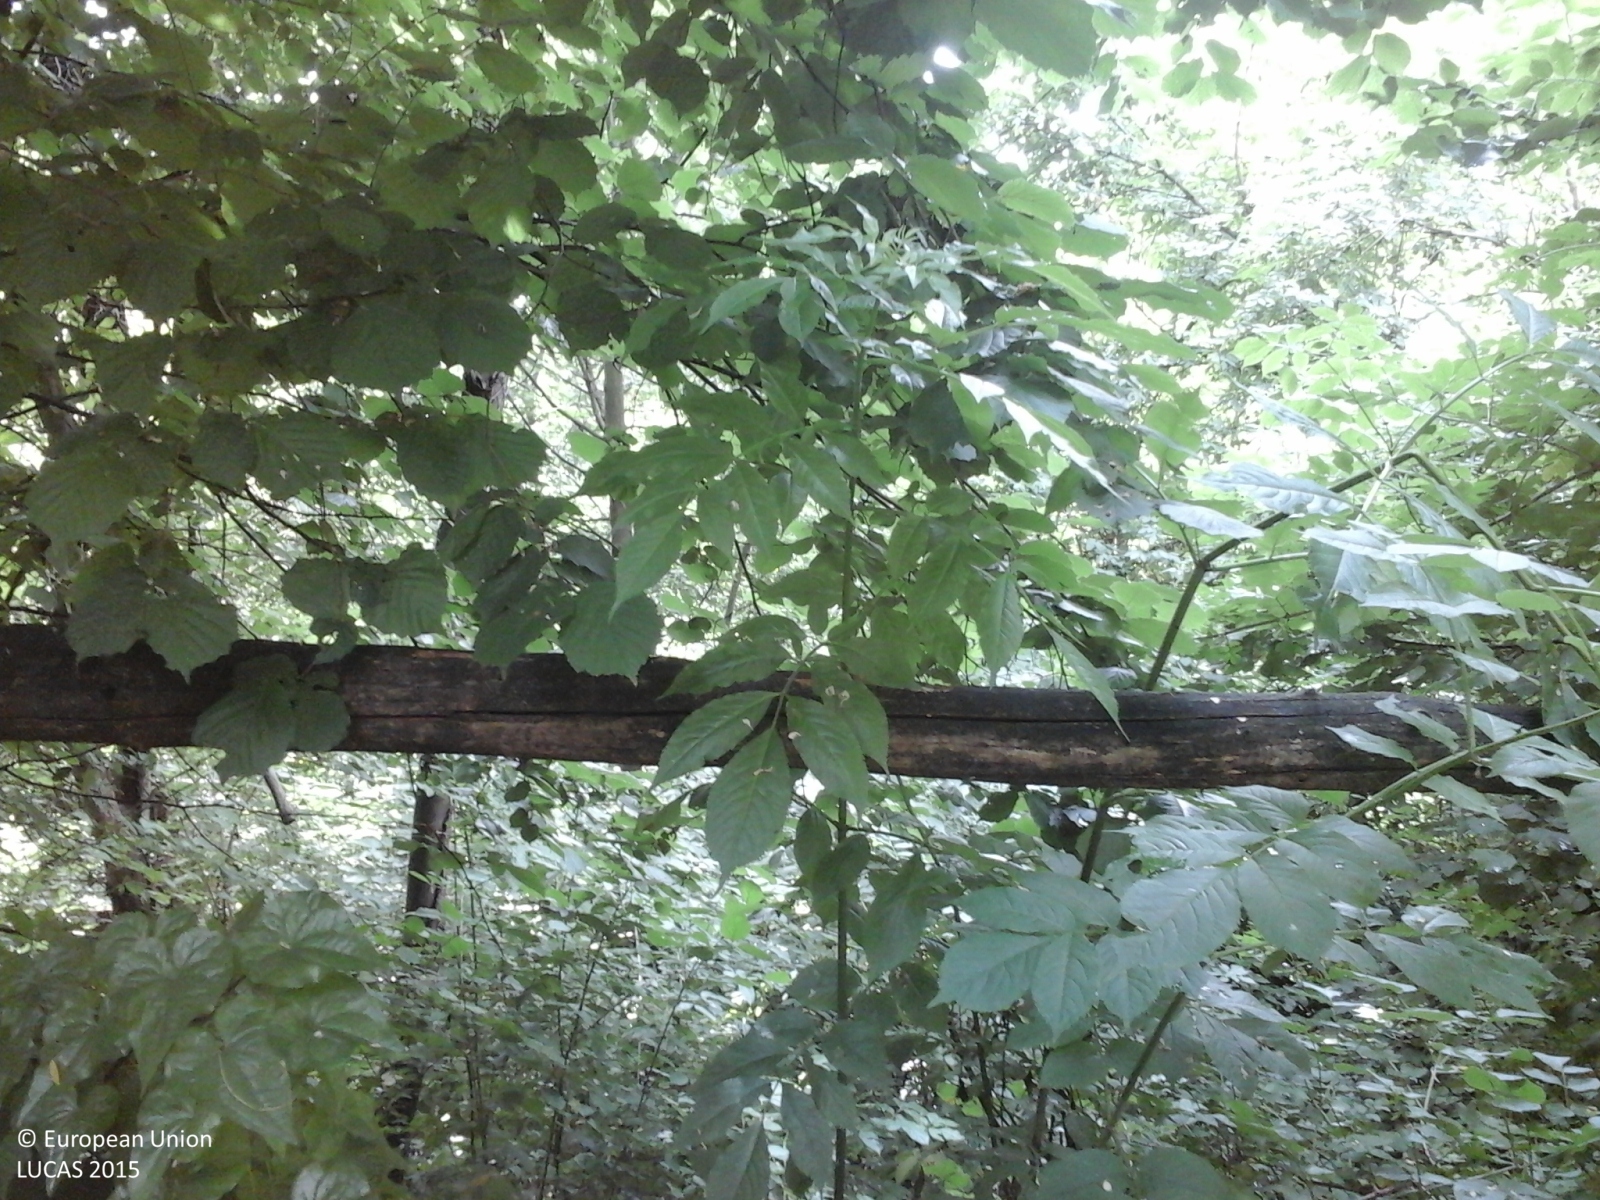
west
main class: Woodland
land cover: Broadleaved woodland
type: thermophilous deciduous forest
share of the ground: > 75 %
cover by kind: broadleaved forest trees 100 %
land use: Semi-natural and natural areas not in use
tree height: > 5 m
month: June
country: IT
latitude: 45.1024
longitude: 7.7799
